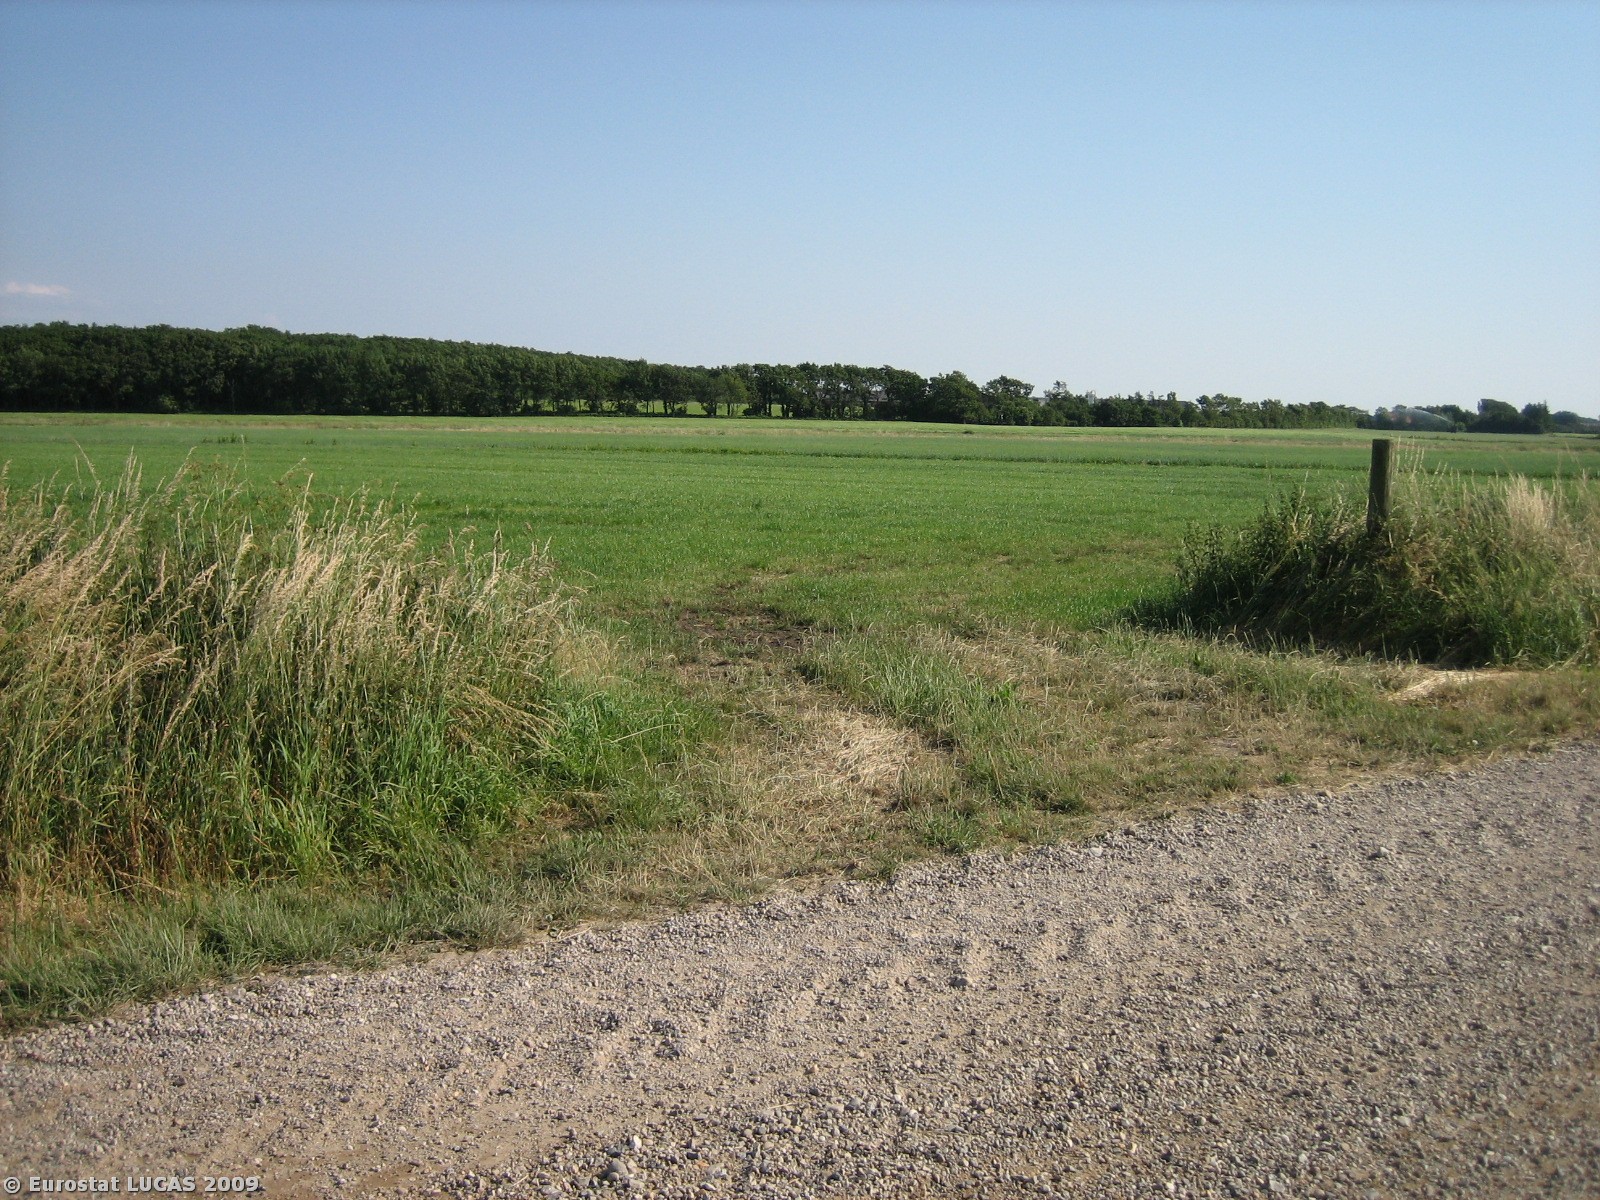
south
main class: Cropland
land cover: Barley
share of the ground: > 75 %
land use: Agriculture (excluding fallow land and kitchen gardens)
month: July
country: DK
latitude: 55.3736
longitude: 8.8491
